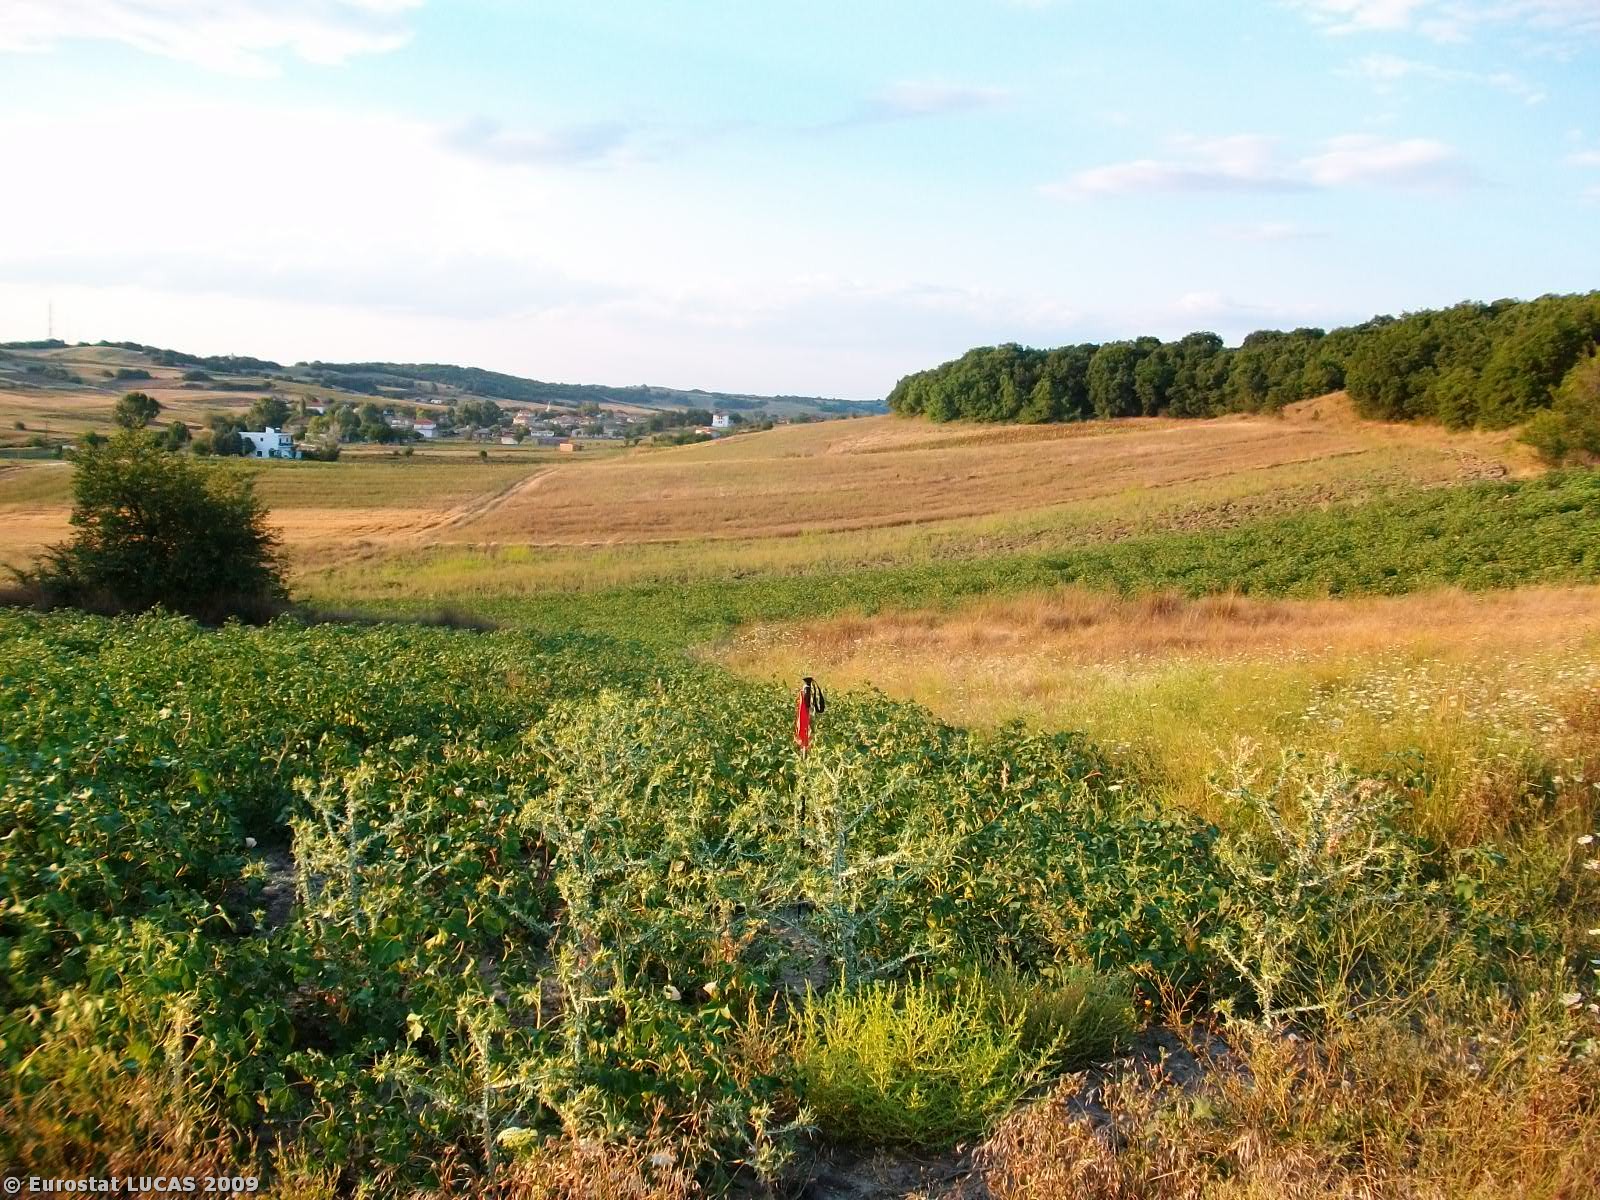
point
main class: Cropland
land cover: Cotton
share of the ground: 50 - 75 %
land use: Agriculture (excluding fallow land and kitchen gardens)
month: August
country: GR
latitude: 41.3944
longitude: 26.4250
